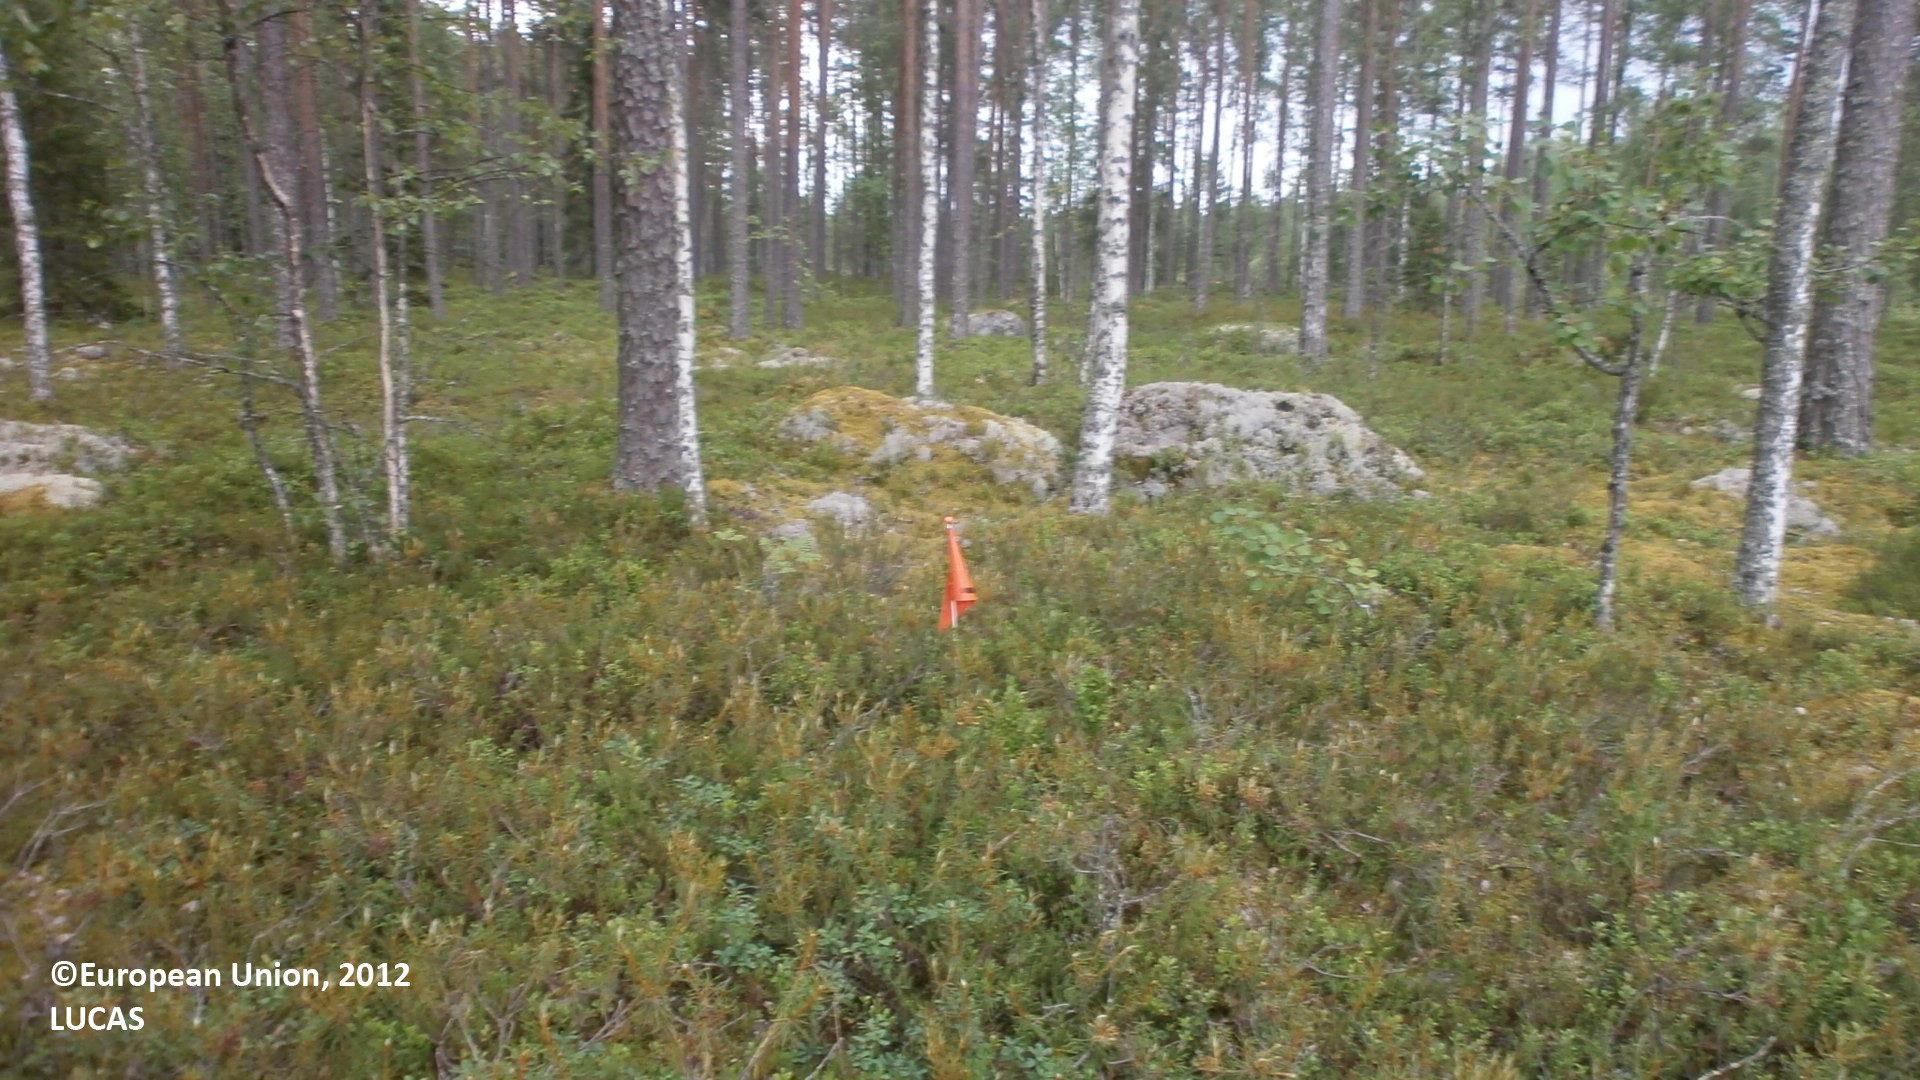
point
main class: Woodland
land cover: Pine dominated coniferous woodland
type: boreal forest
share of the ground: 50 - 75 %
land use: Forestry
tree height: > 5 m
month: July
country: FI
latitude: 63.9387
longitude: 24.2078
